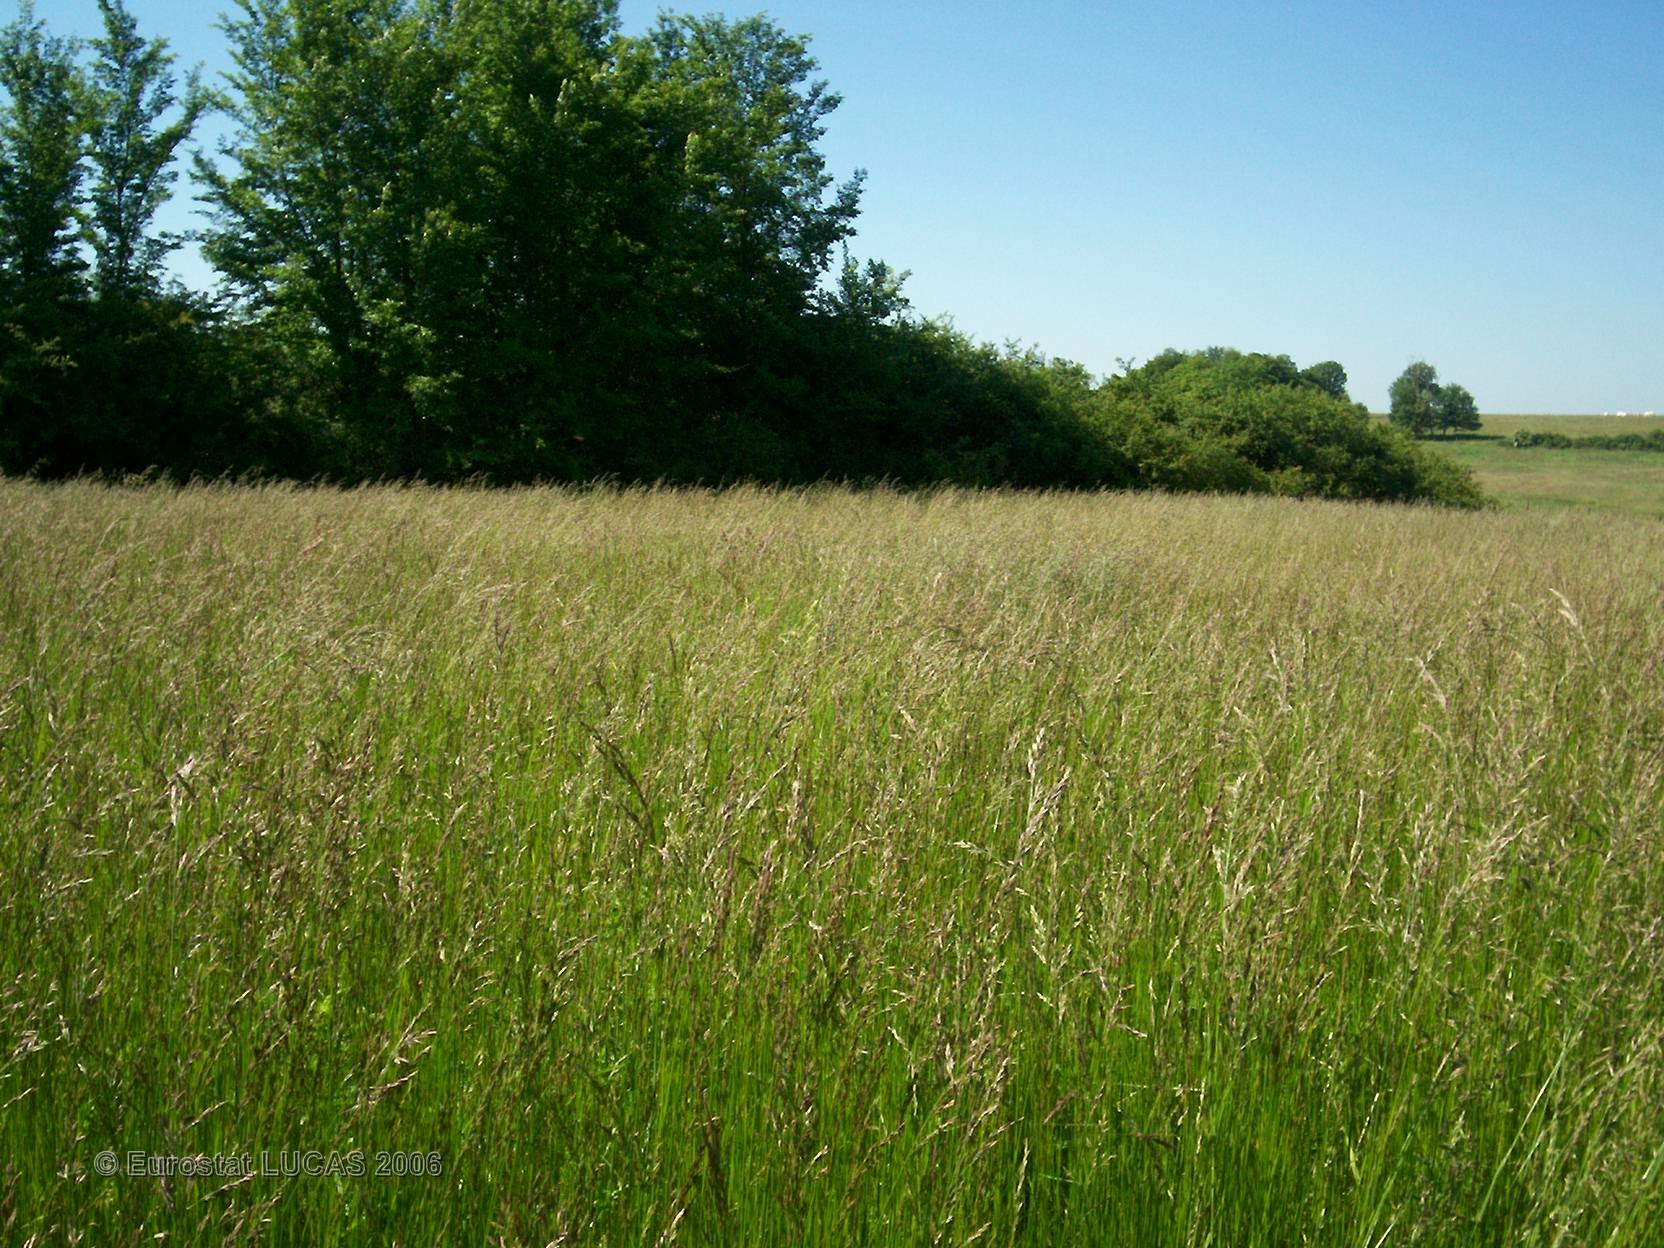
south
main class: Grassland
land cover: Grassland without tree/shrub cover
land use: Agriculture (excluding fallow land and kitchen gardens)
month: June
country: FR
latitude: 48.5802
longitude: 4.6432
